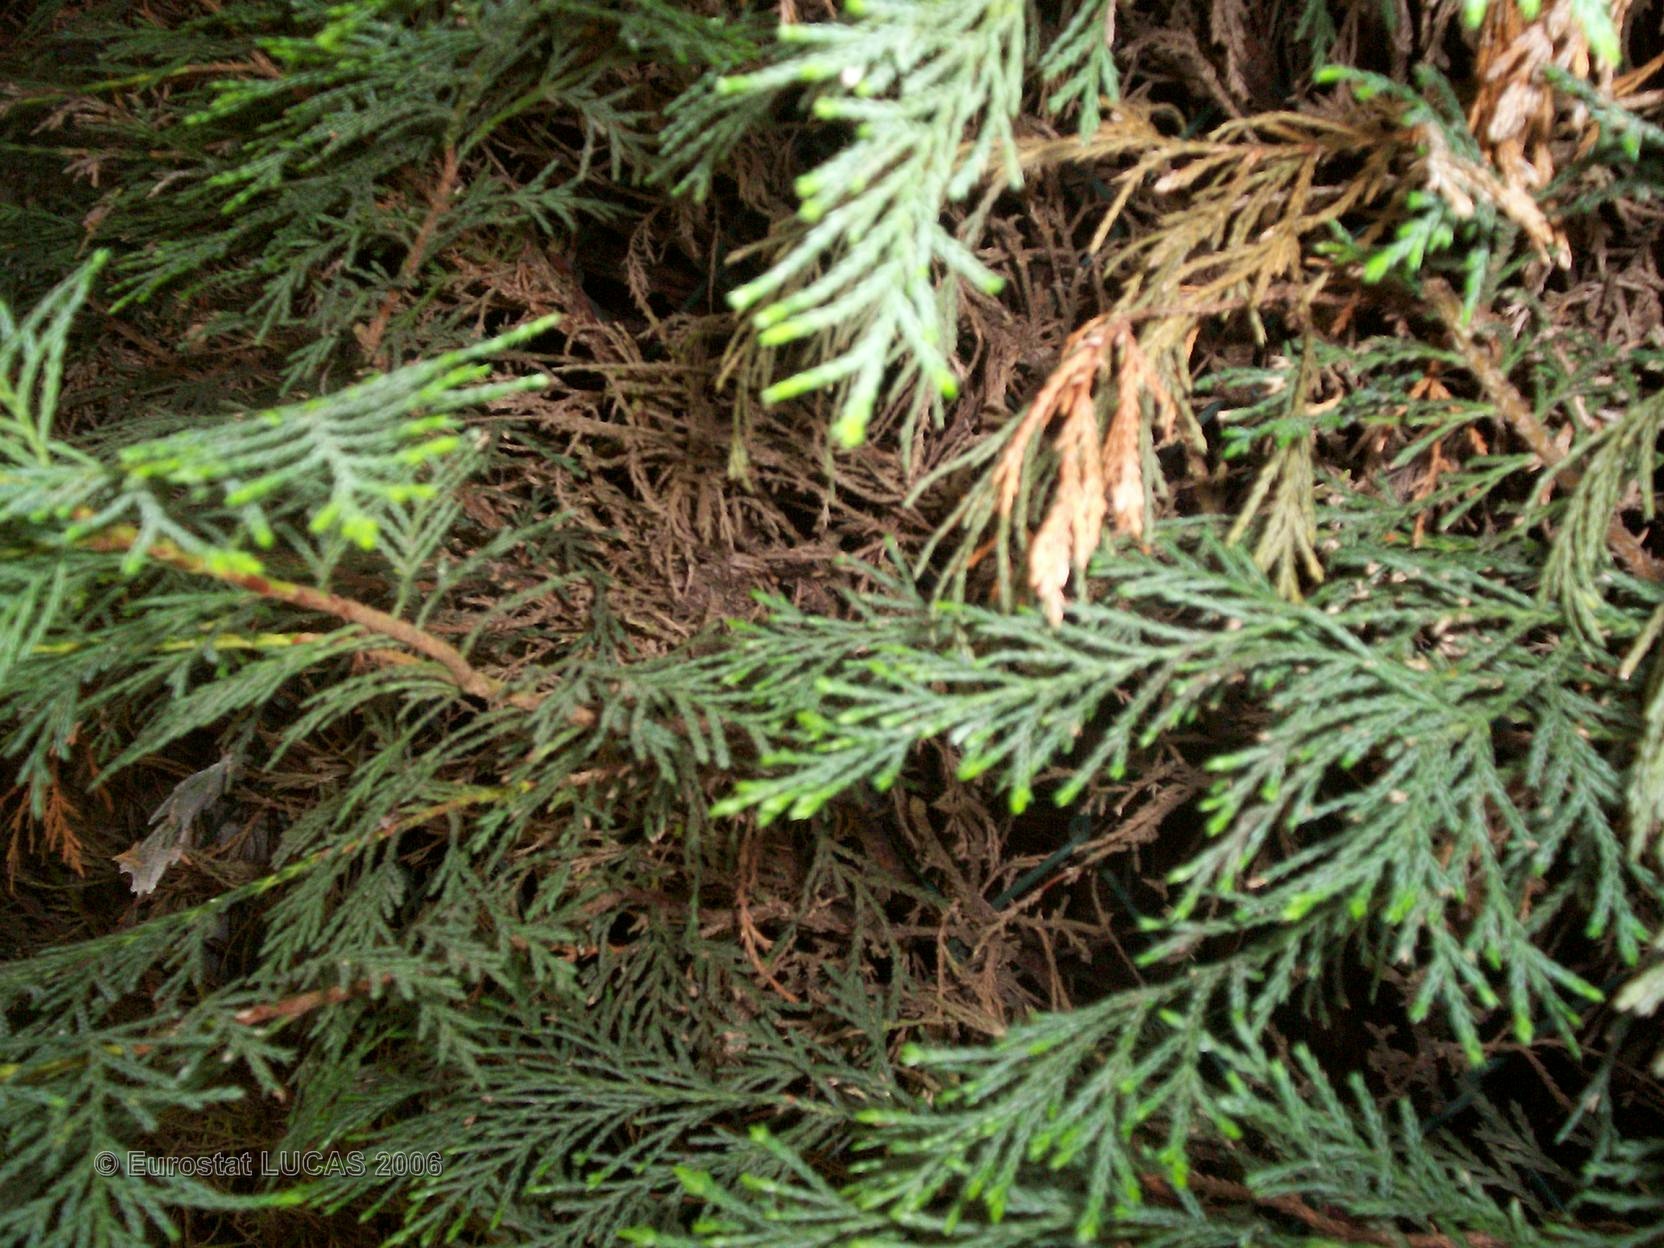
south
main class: Grassland
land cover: Grassland with sparse tree/shrub cover
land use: Residential
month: June
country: FR
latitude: 49.7498
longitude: 2.6745
